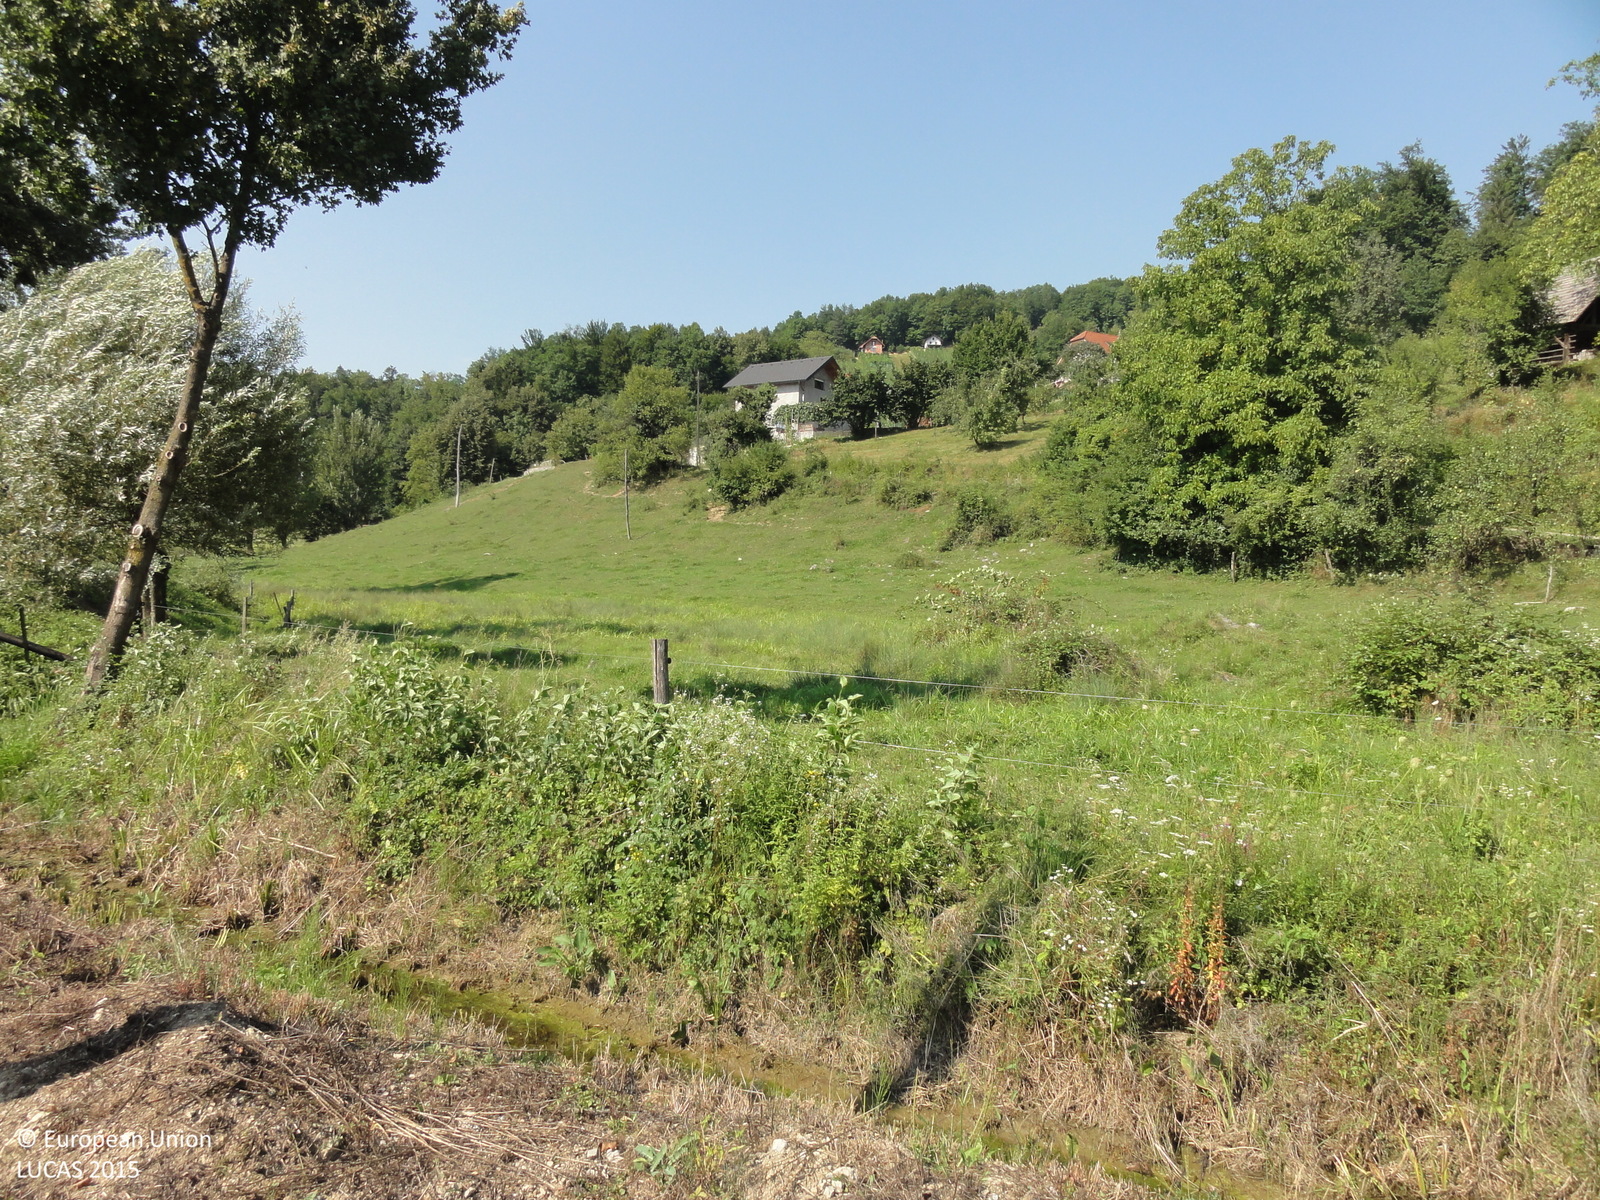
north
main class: Grassland
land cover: Grassland without tree/shrub cover
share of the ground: 50 - 75 %
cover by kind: herbaceous plants 60 %
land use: Residential
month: August
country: SI
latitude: 45.9065
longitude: 15.0627
